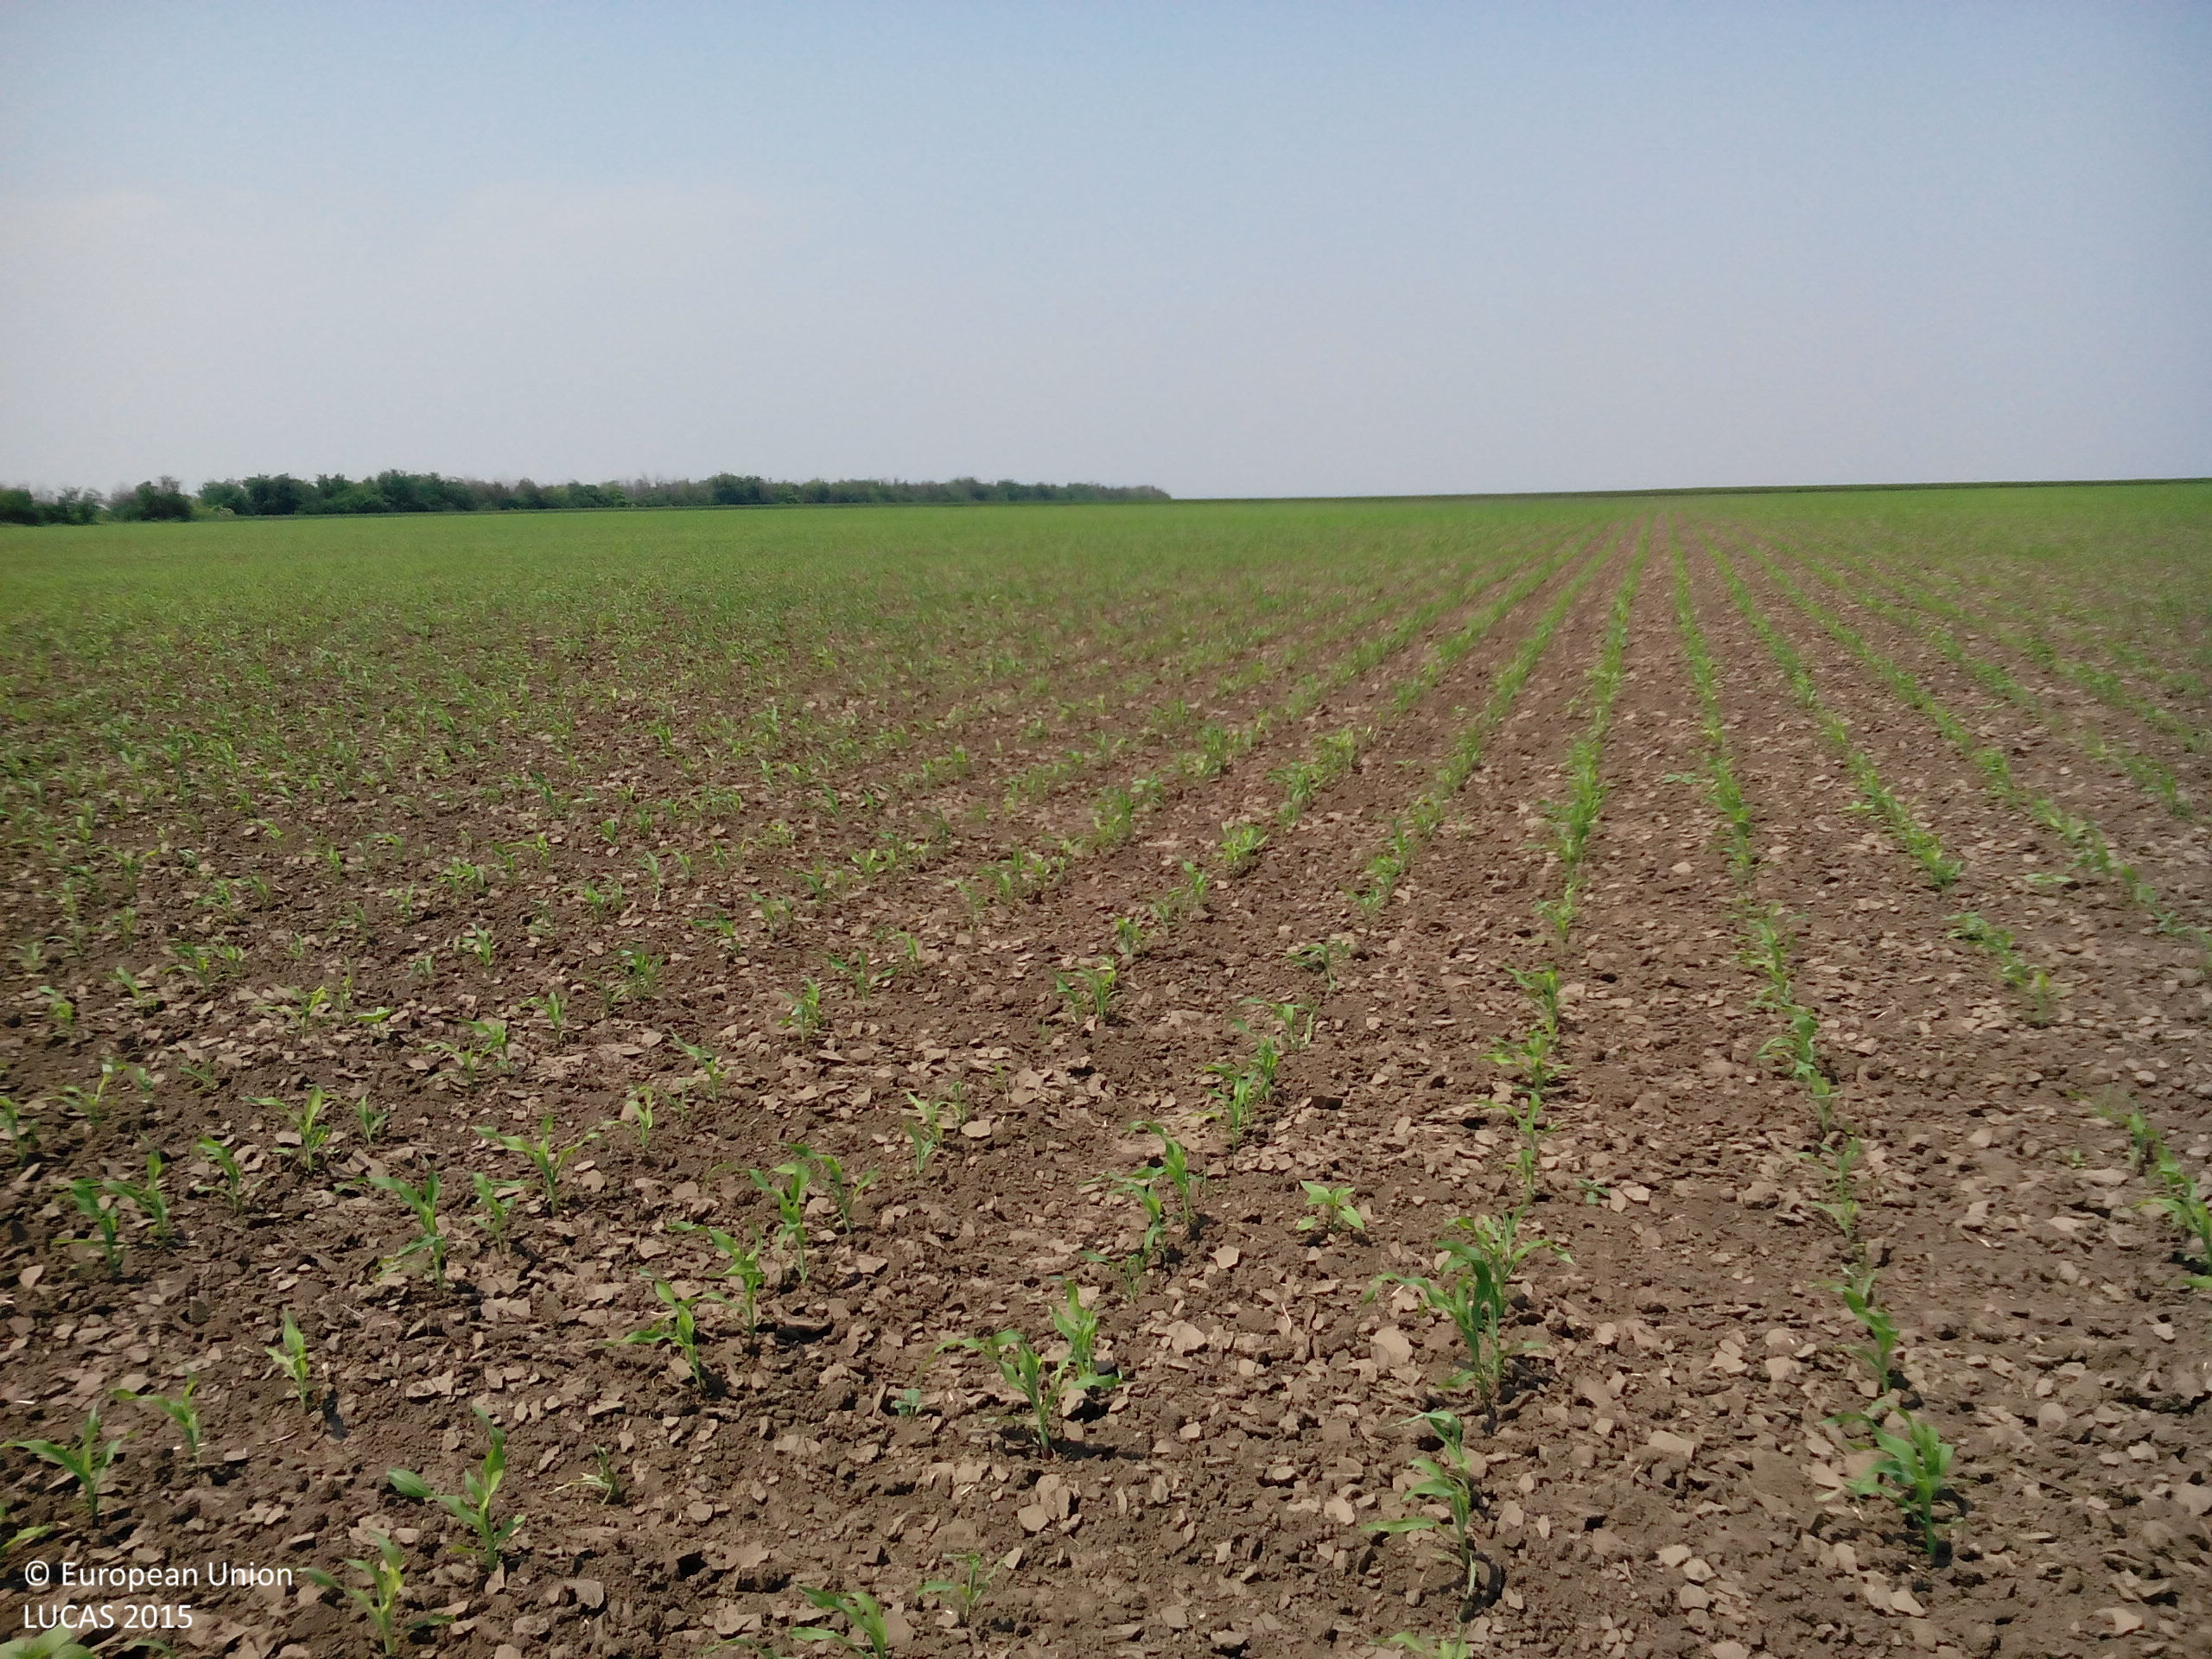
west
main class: Cropland
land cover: Maize
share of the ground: 10 - 25 %
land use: Agriculture (excluding fallow land and kitchen gardens)
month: May
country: BG
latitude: 43.6062
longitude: 24.0671
